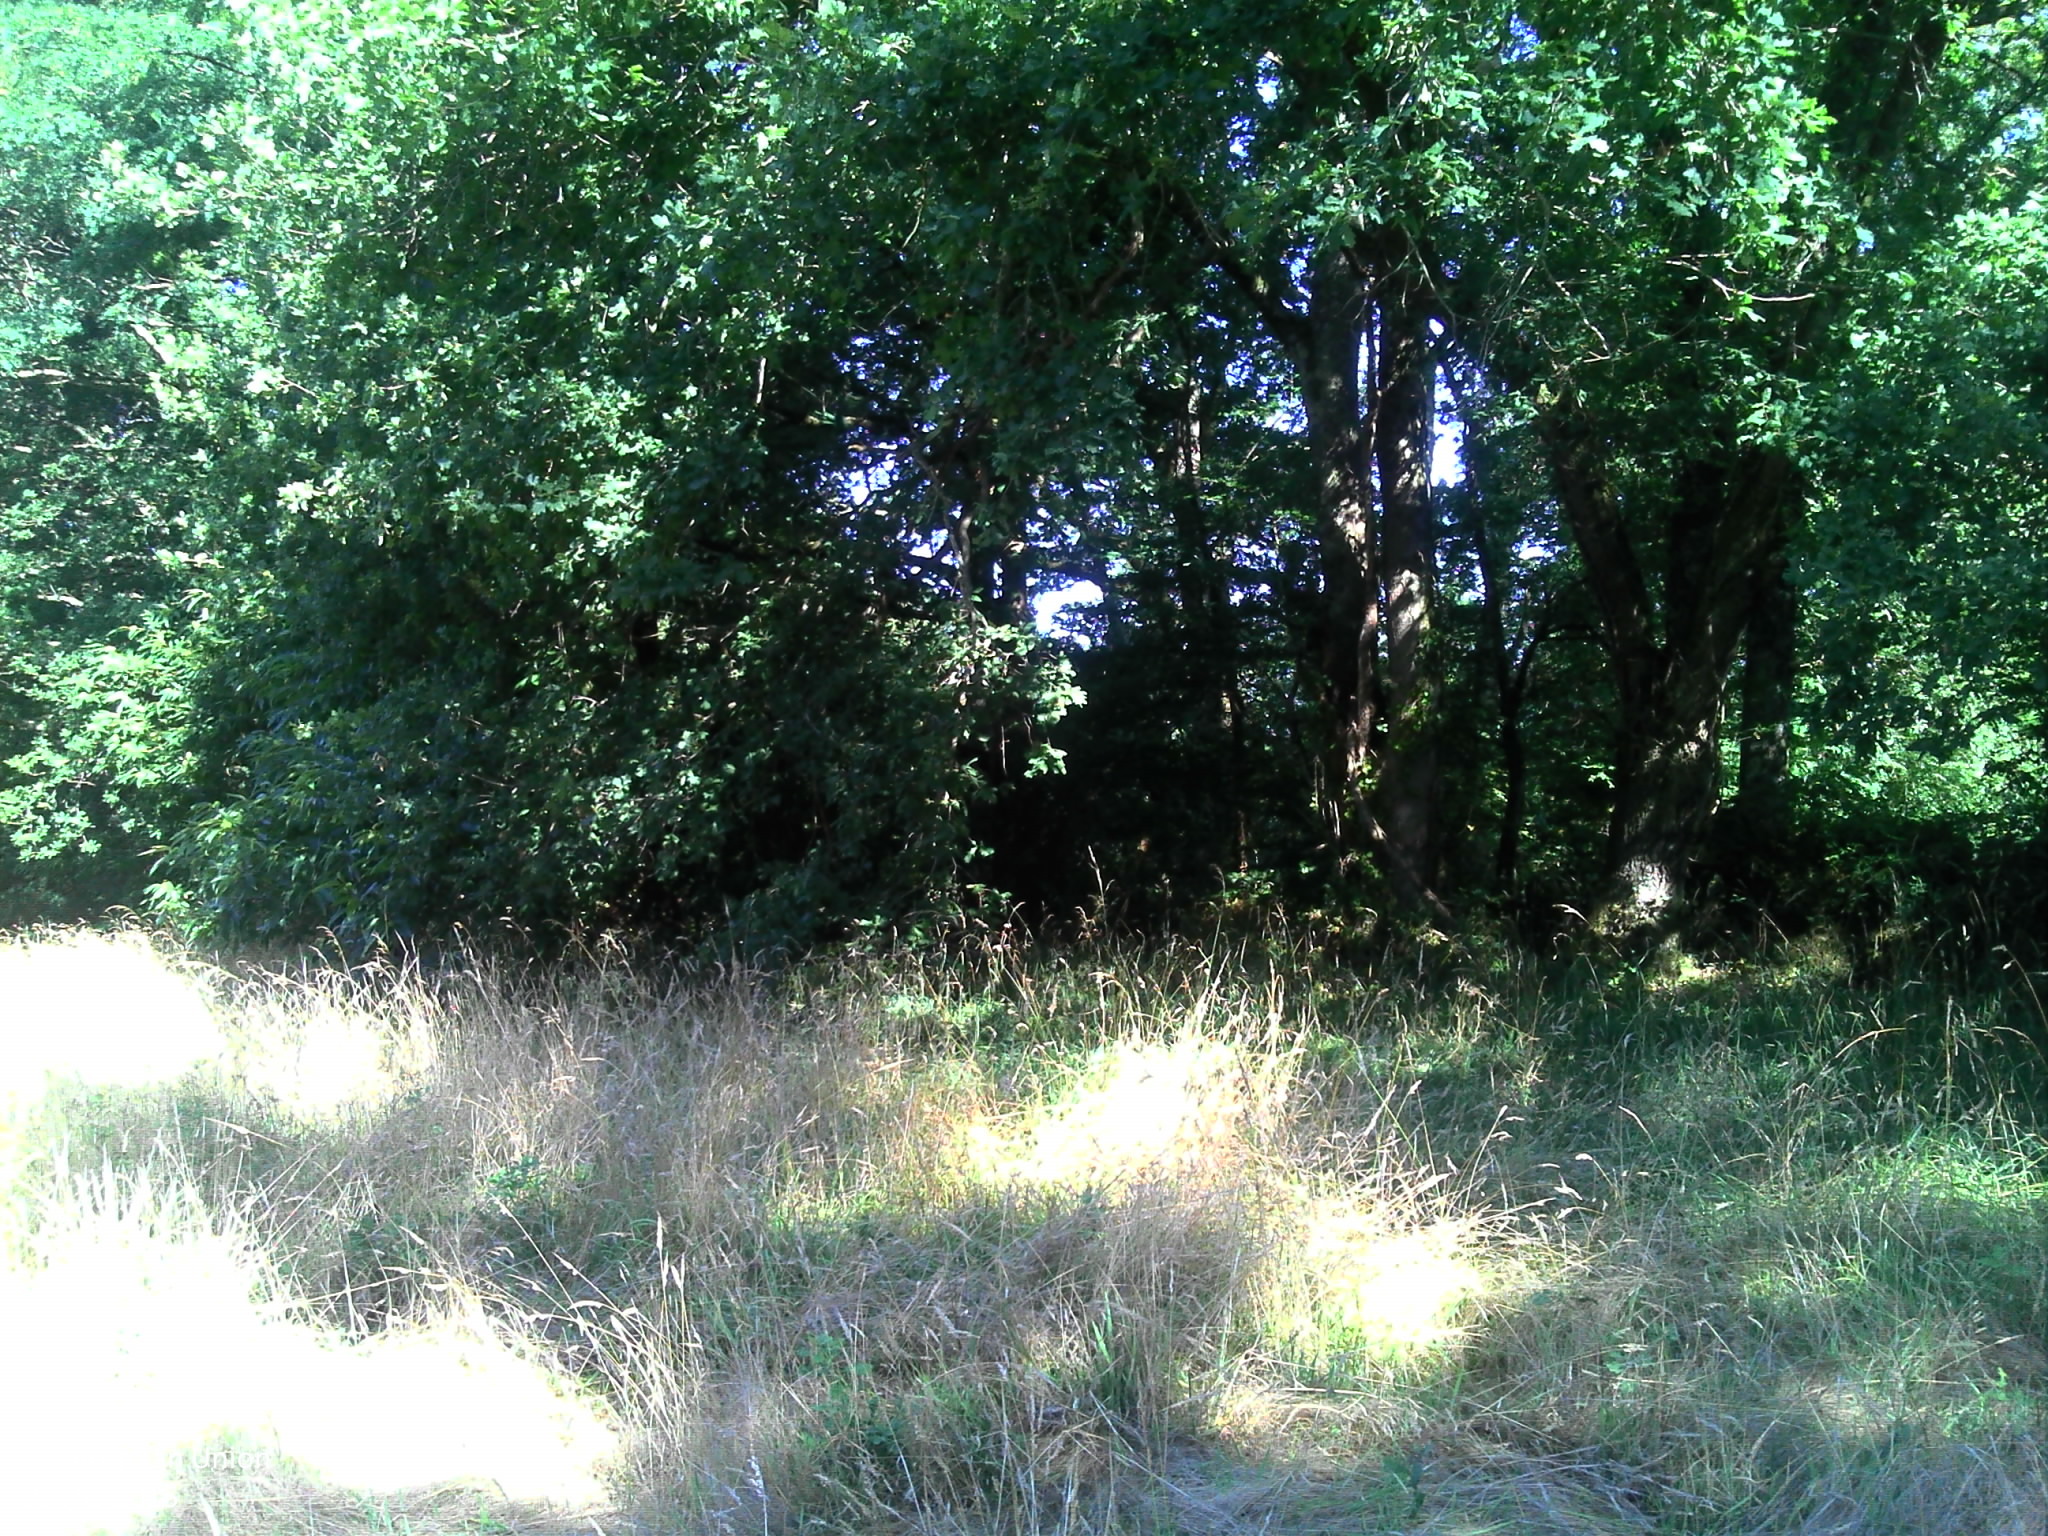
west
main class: Grassland
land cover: Grassland without tree/shrub cover
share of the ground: > 75 %
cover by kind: herbaceous plants 95 %, shrubs 5 %
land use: Agriculture (excluding fallow land and kitchen gardens)
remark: Temporary dry
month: July
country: FR
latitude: 43.6428
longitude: -1.1108
